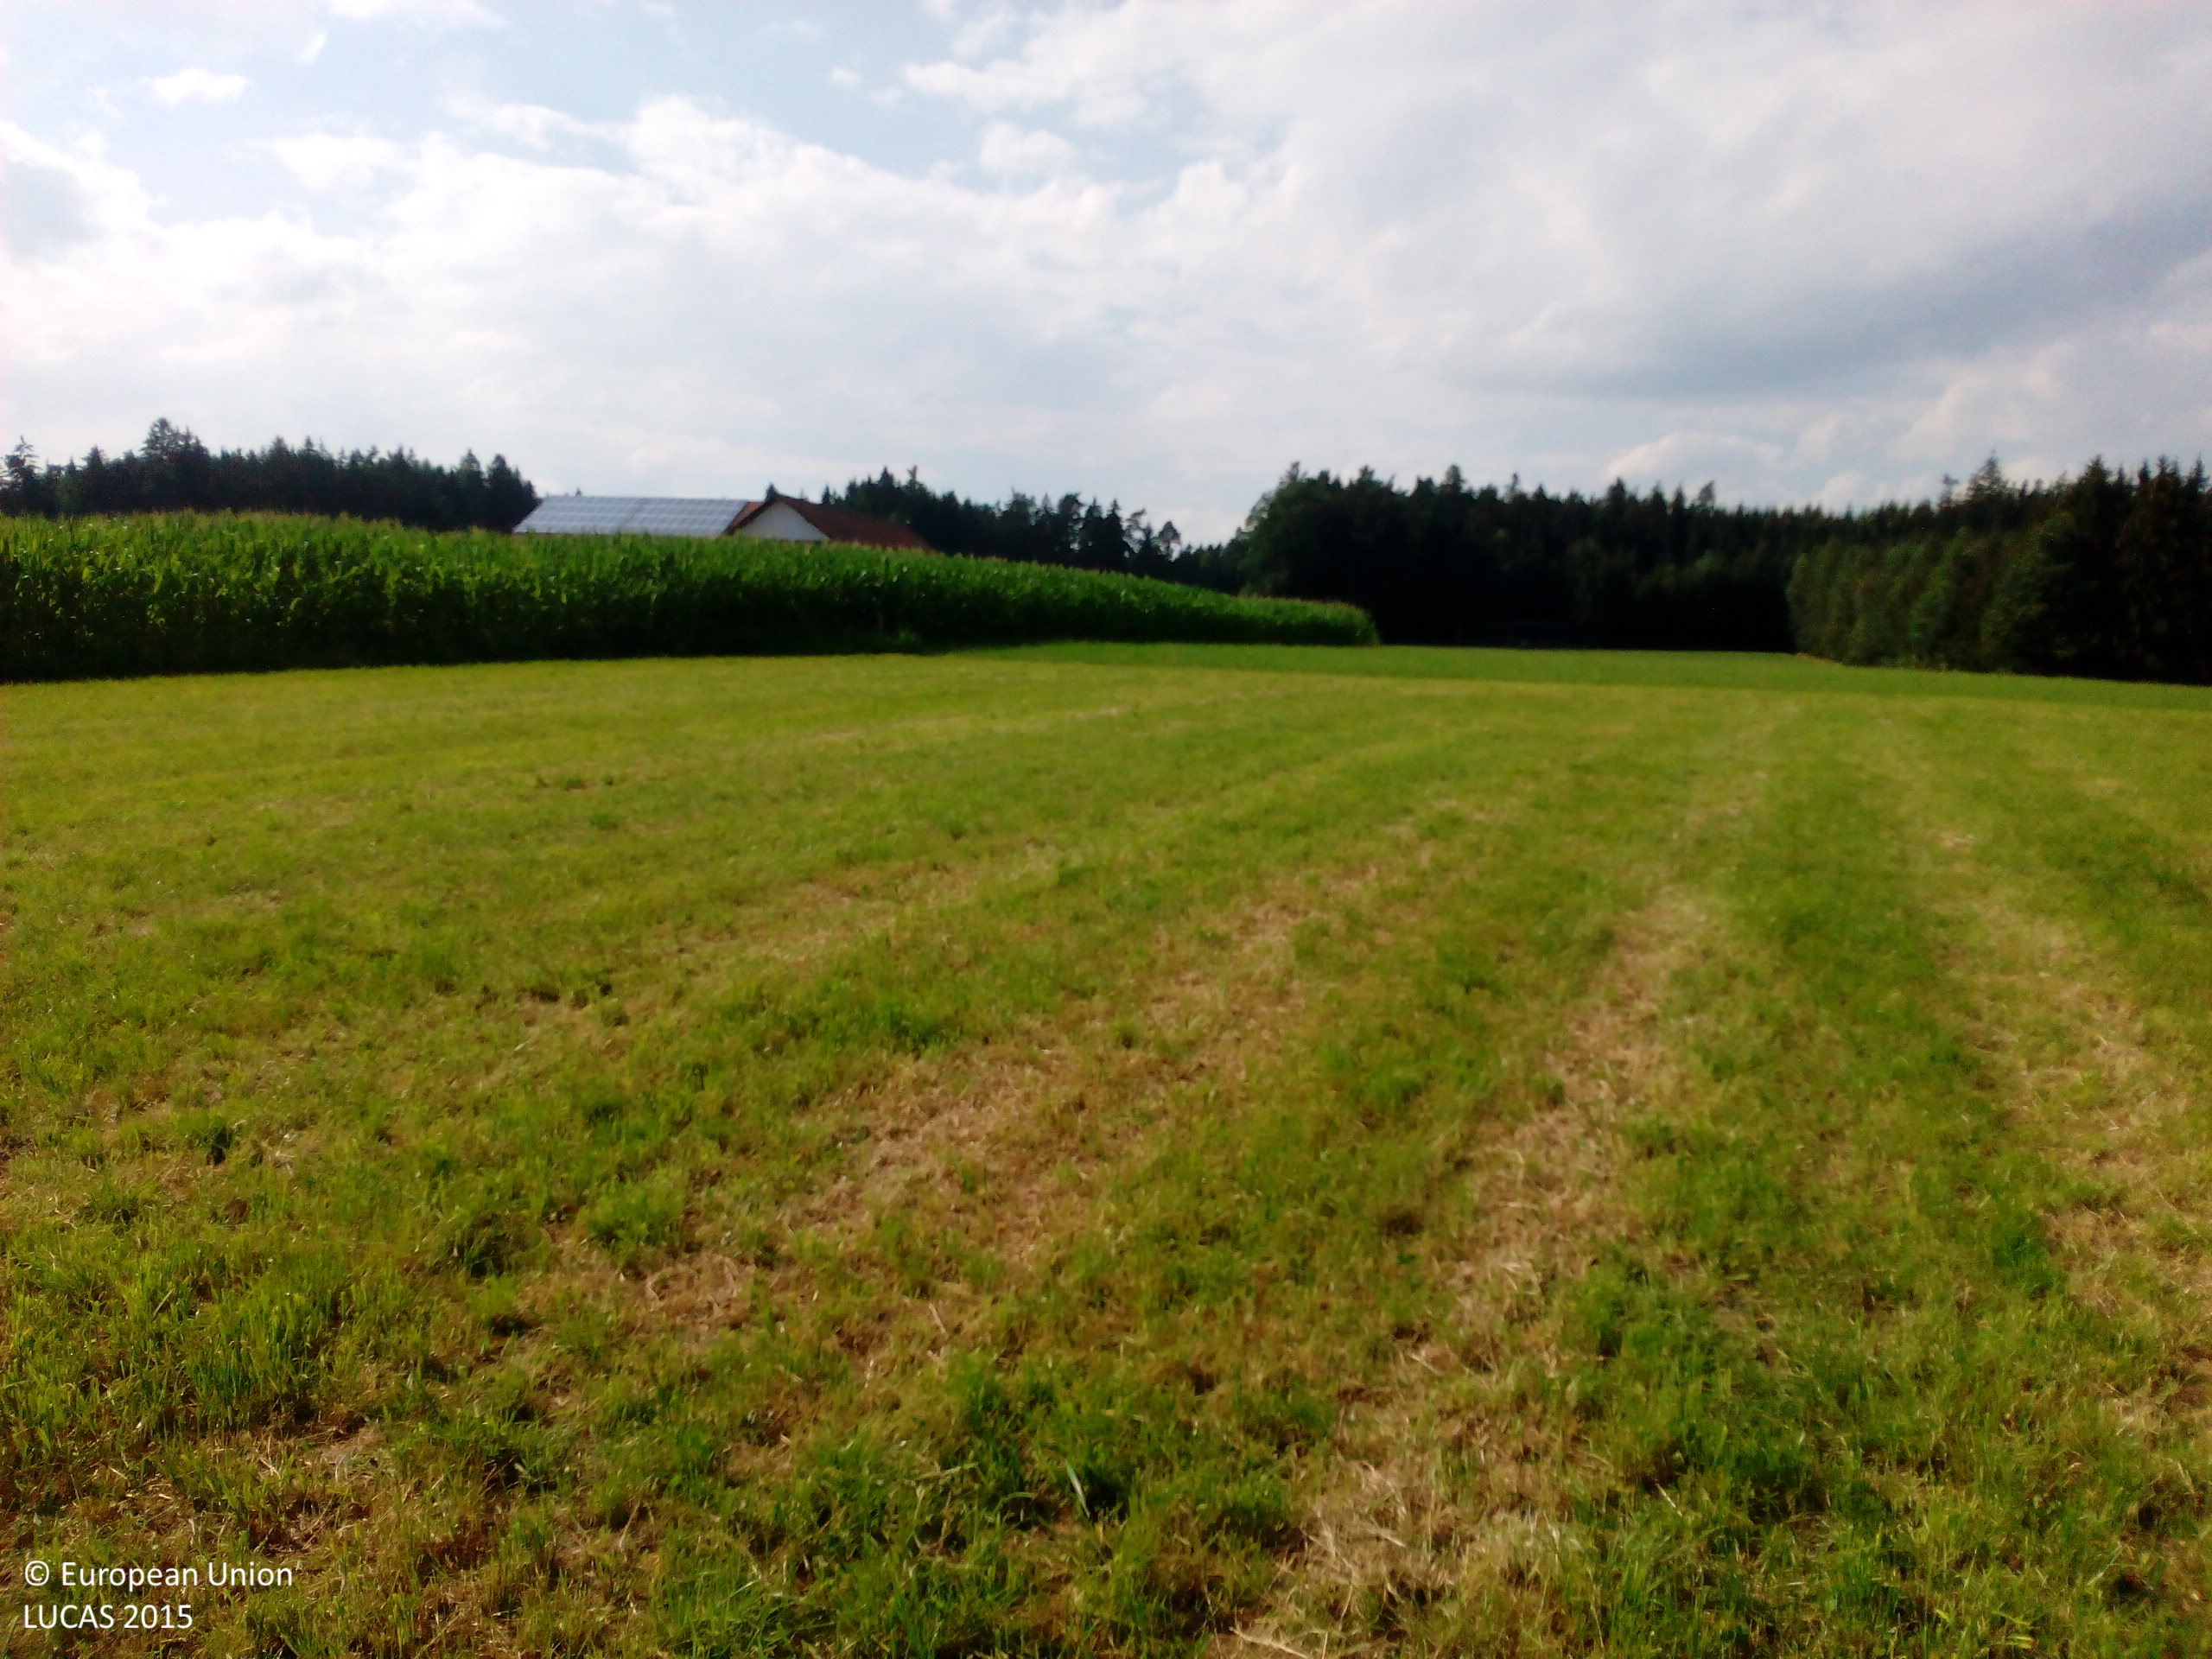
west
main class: Grassland
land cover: Grassland without tree/shrub cover
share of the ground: > 75 %
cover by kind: herbaceous plants 100 %
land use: Agriculture (excluding fallow land and kitchen gardens)
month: July
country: DE
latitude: 48.3834
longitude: 12.9022
